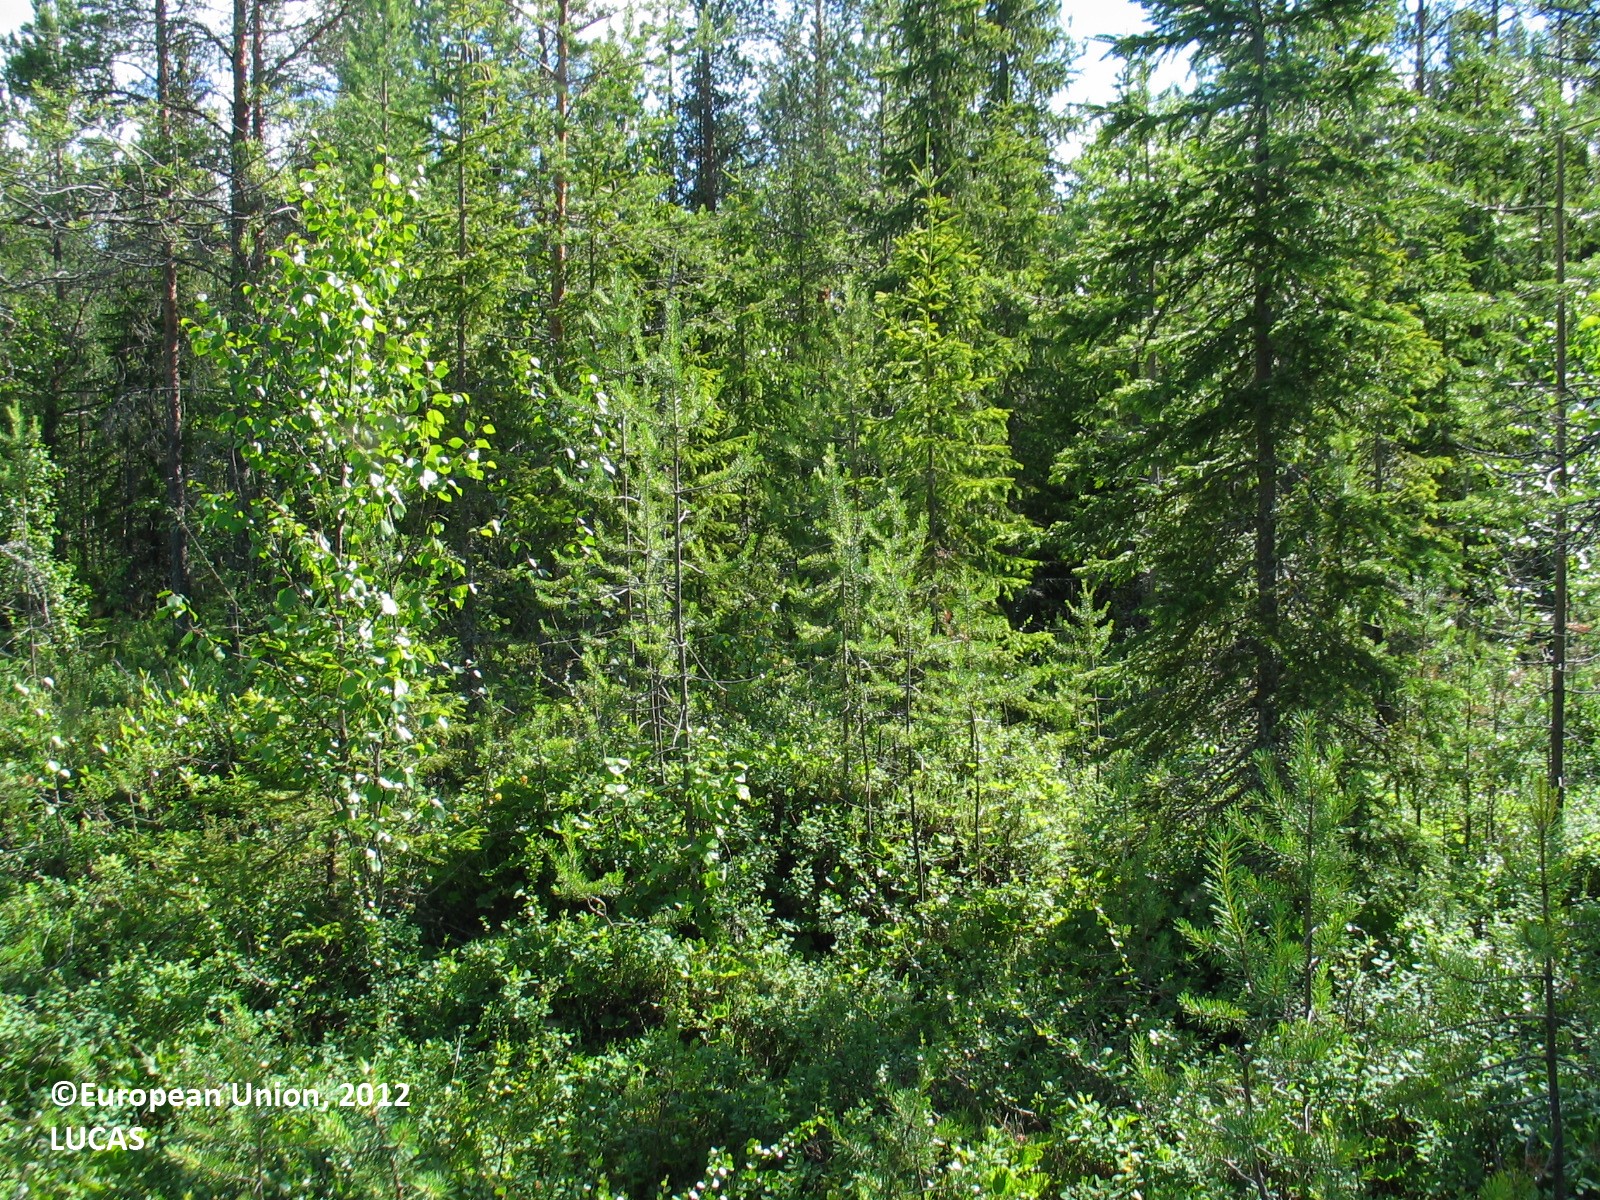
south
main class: Woodland
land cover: Pine dominated coniferous woodland
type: mire and swamp forests
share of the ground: 25 - 50 %
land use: Forestry
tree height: > 5 m
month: July
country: FI
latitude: 65.9213
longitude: 24.9310
